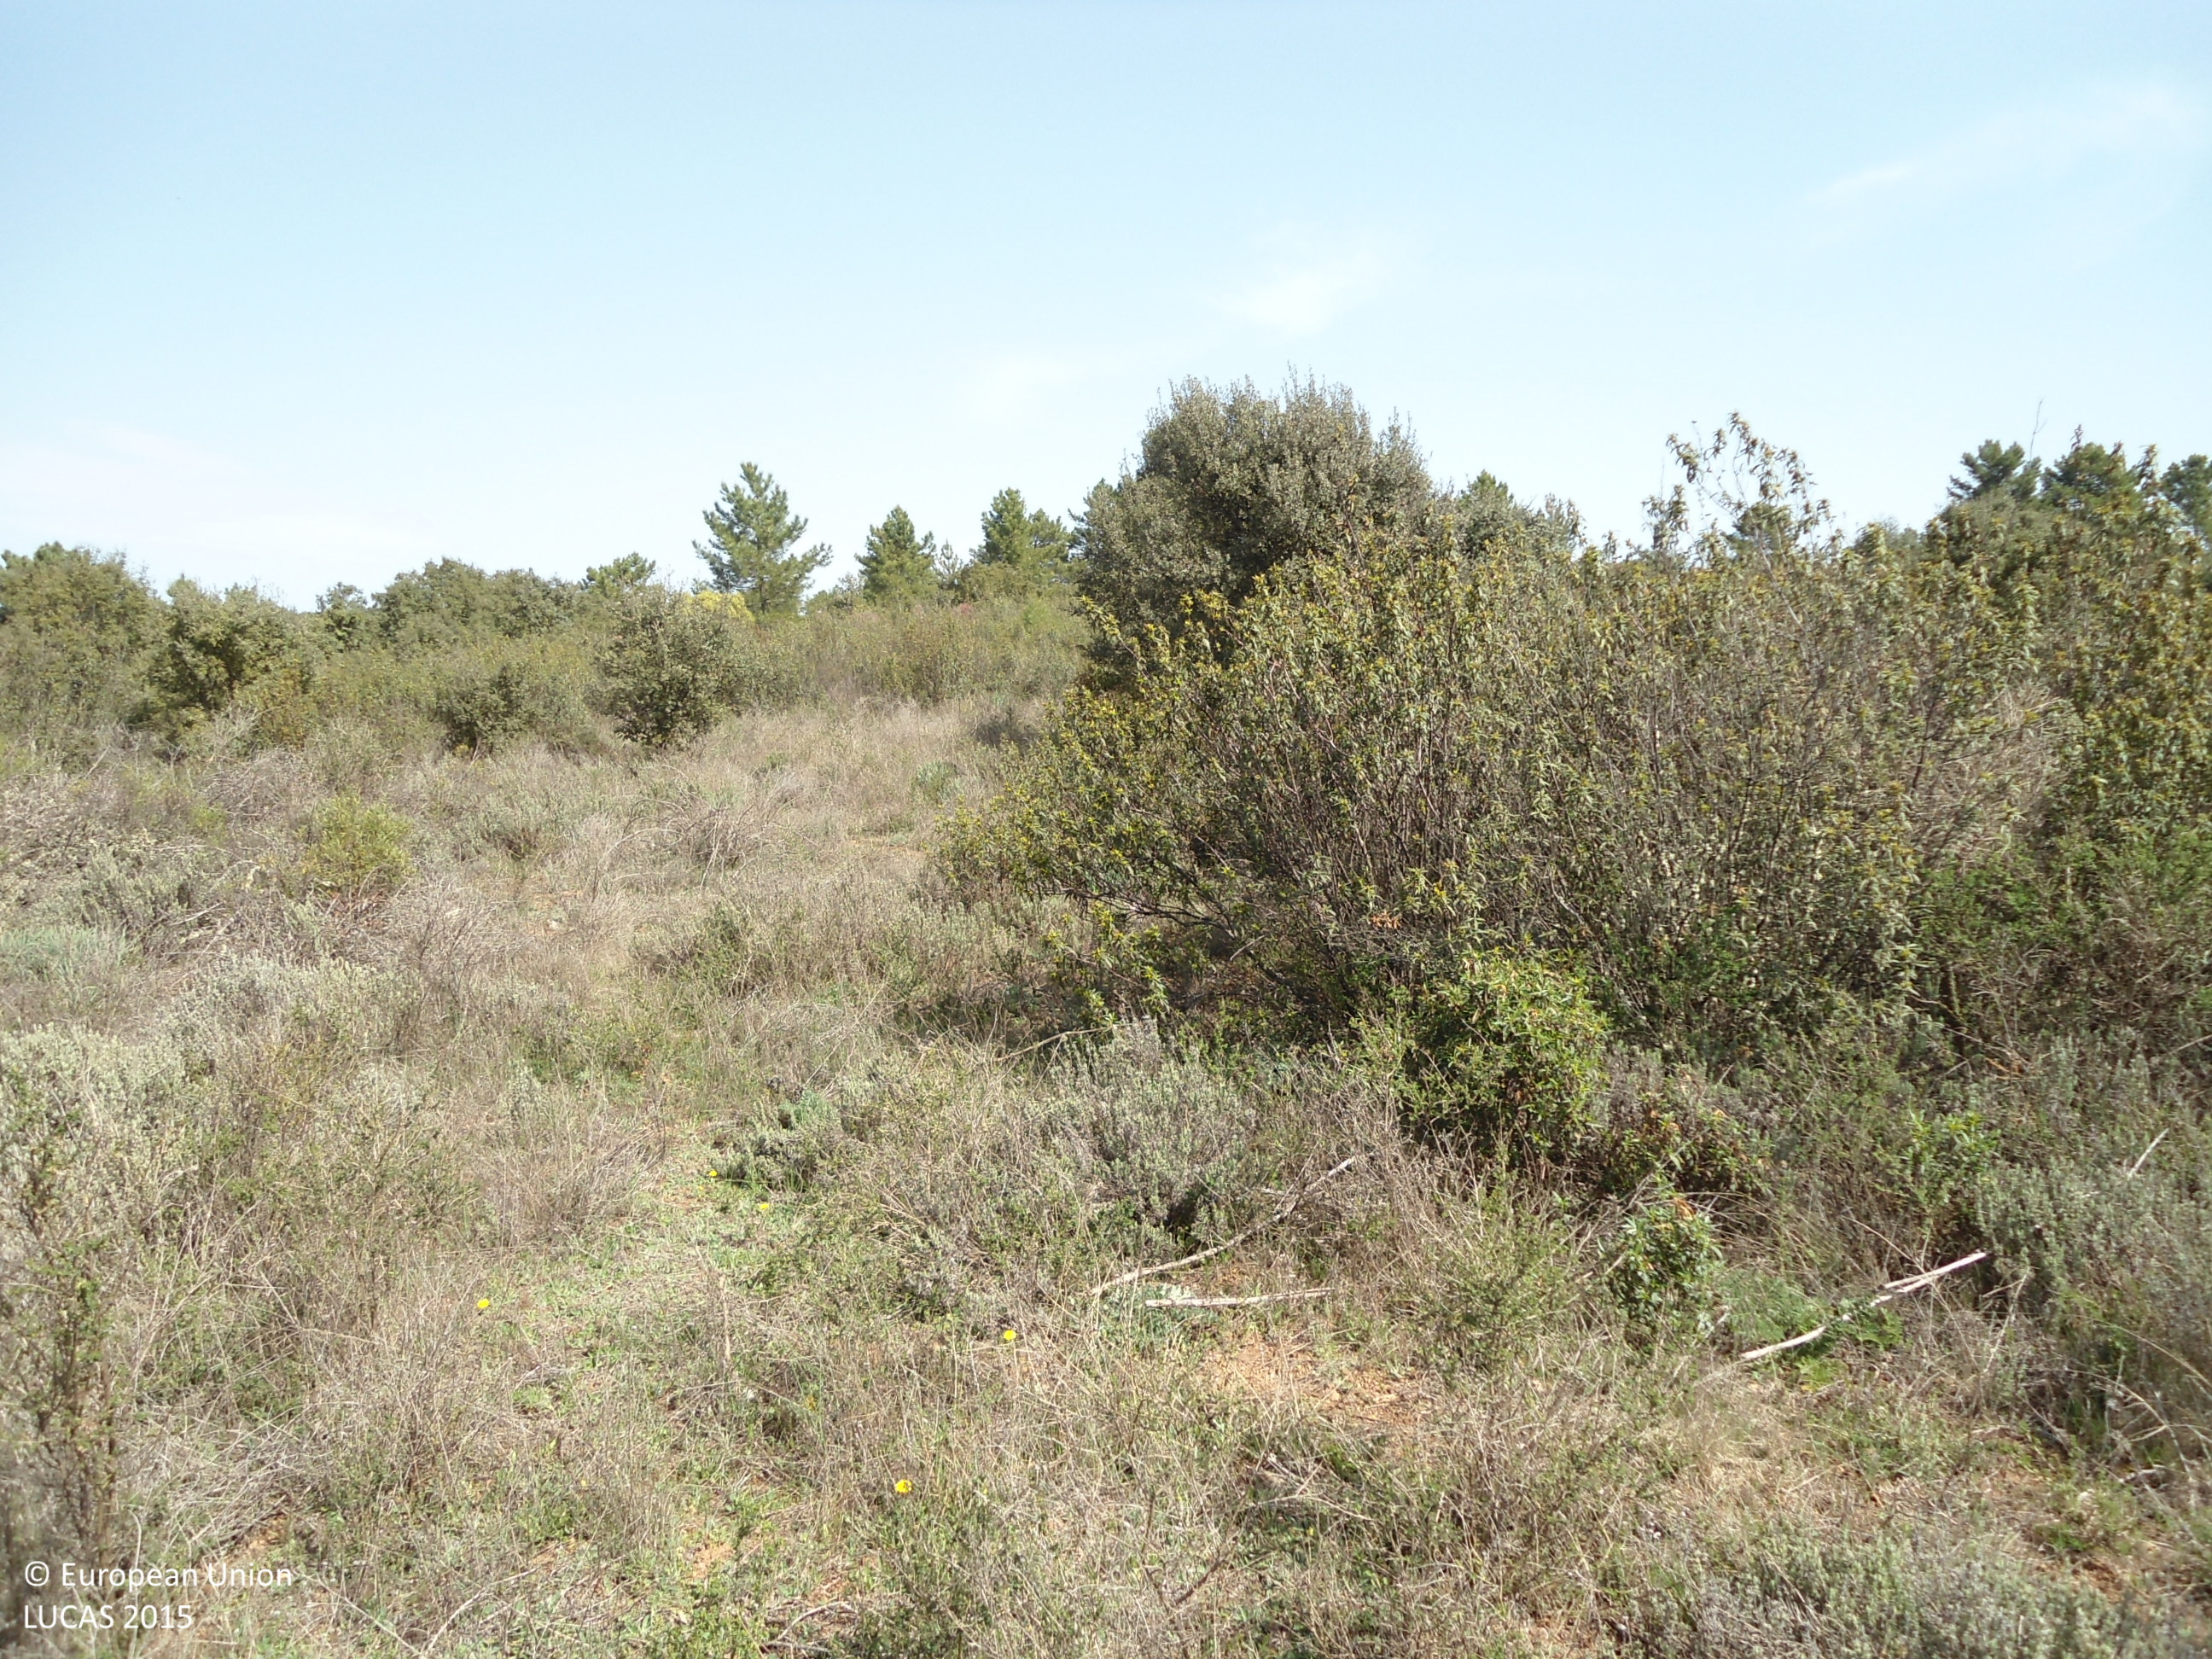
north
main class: Shrubland
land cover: Shrubland without tree cover
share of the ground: > 75 %
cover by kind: shrubs 90 %, herbaceous plants 10 %
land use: Semi-natural and natural areas not in use
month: April
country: ES
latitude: 41.7013
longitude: -6.4595
